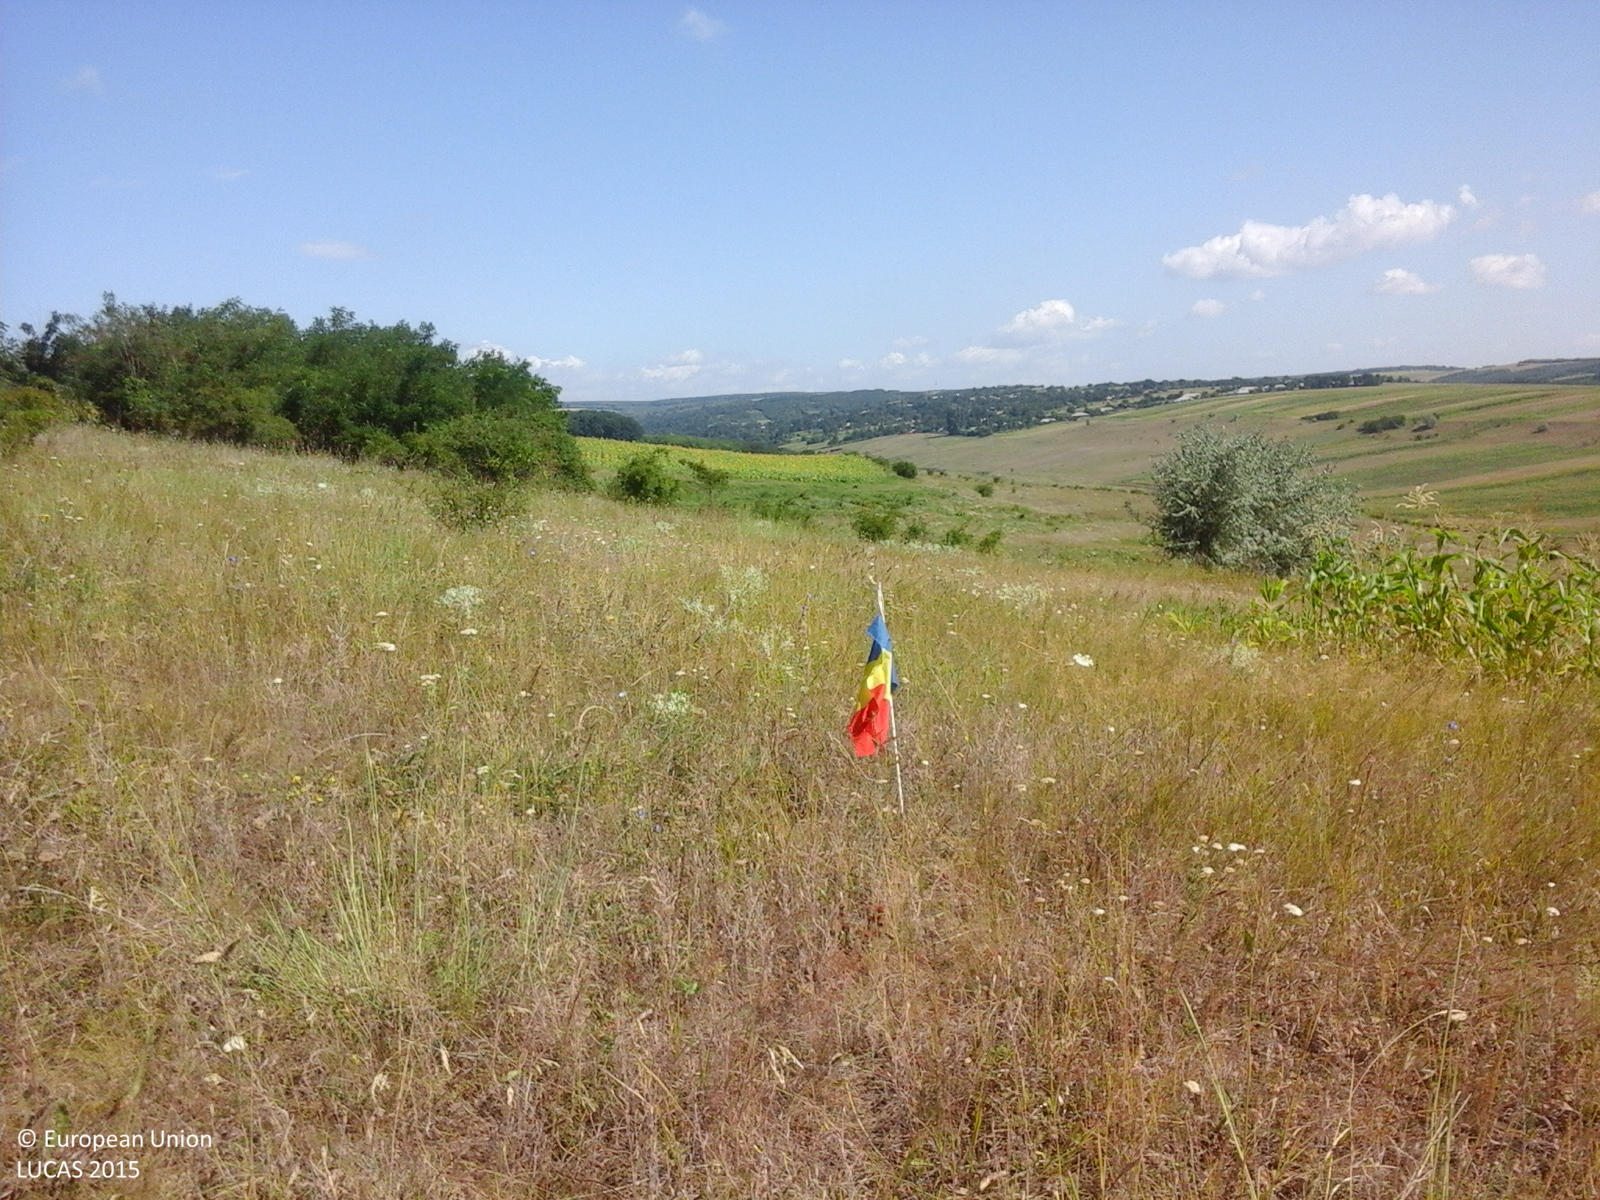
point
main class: Grassland
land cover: Grassland without tree/shrub cover
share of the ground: > 75 %
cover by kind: herbaceous plants 100 %
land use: Agriculture (excluding fallow land and kitchen gardens)
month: July
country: RO
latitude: 46.1613
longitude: 27.8474
